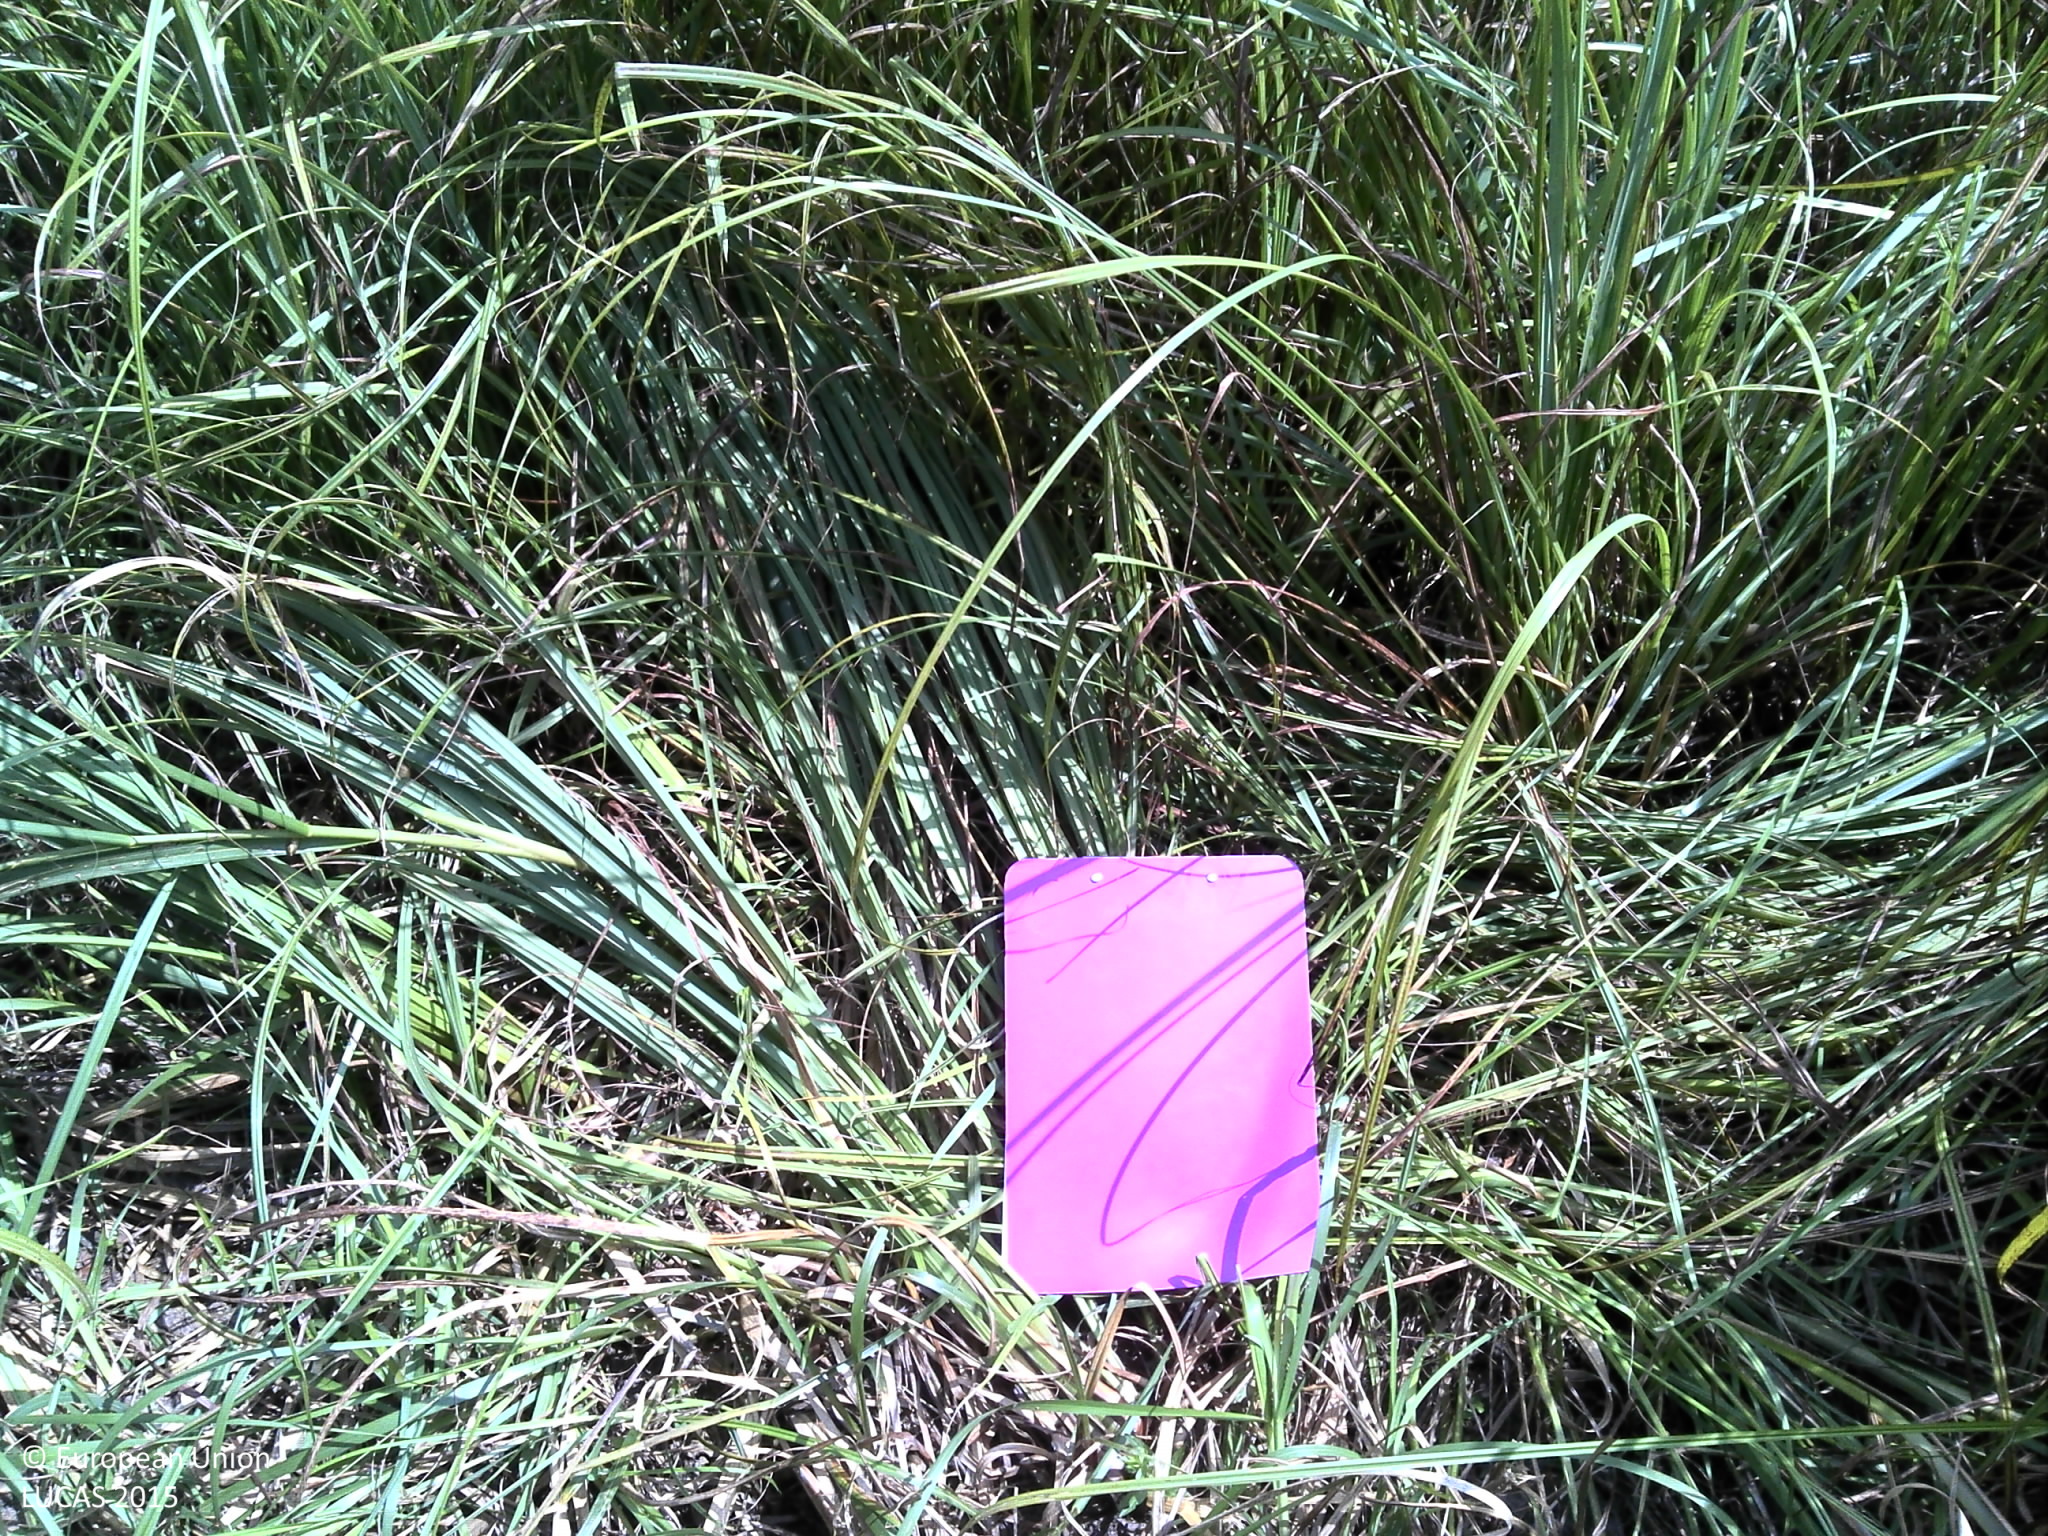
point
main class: Grassland
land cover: Grassland without tree/shrub cover
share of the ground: > 75 %
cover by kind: herbaceous plants 100 %
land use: Semi-natural and natural areas not in use
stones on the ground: < 10 %
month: August
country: HR
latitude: 45.4942
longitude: 16.6398
